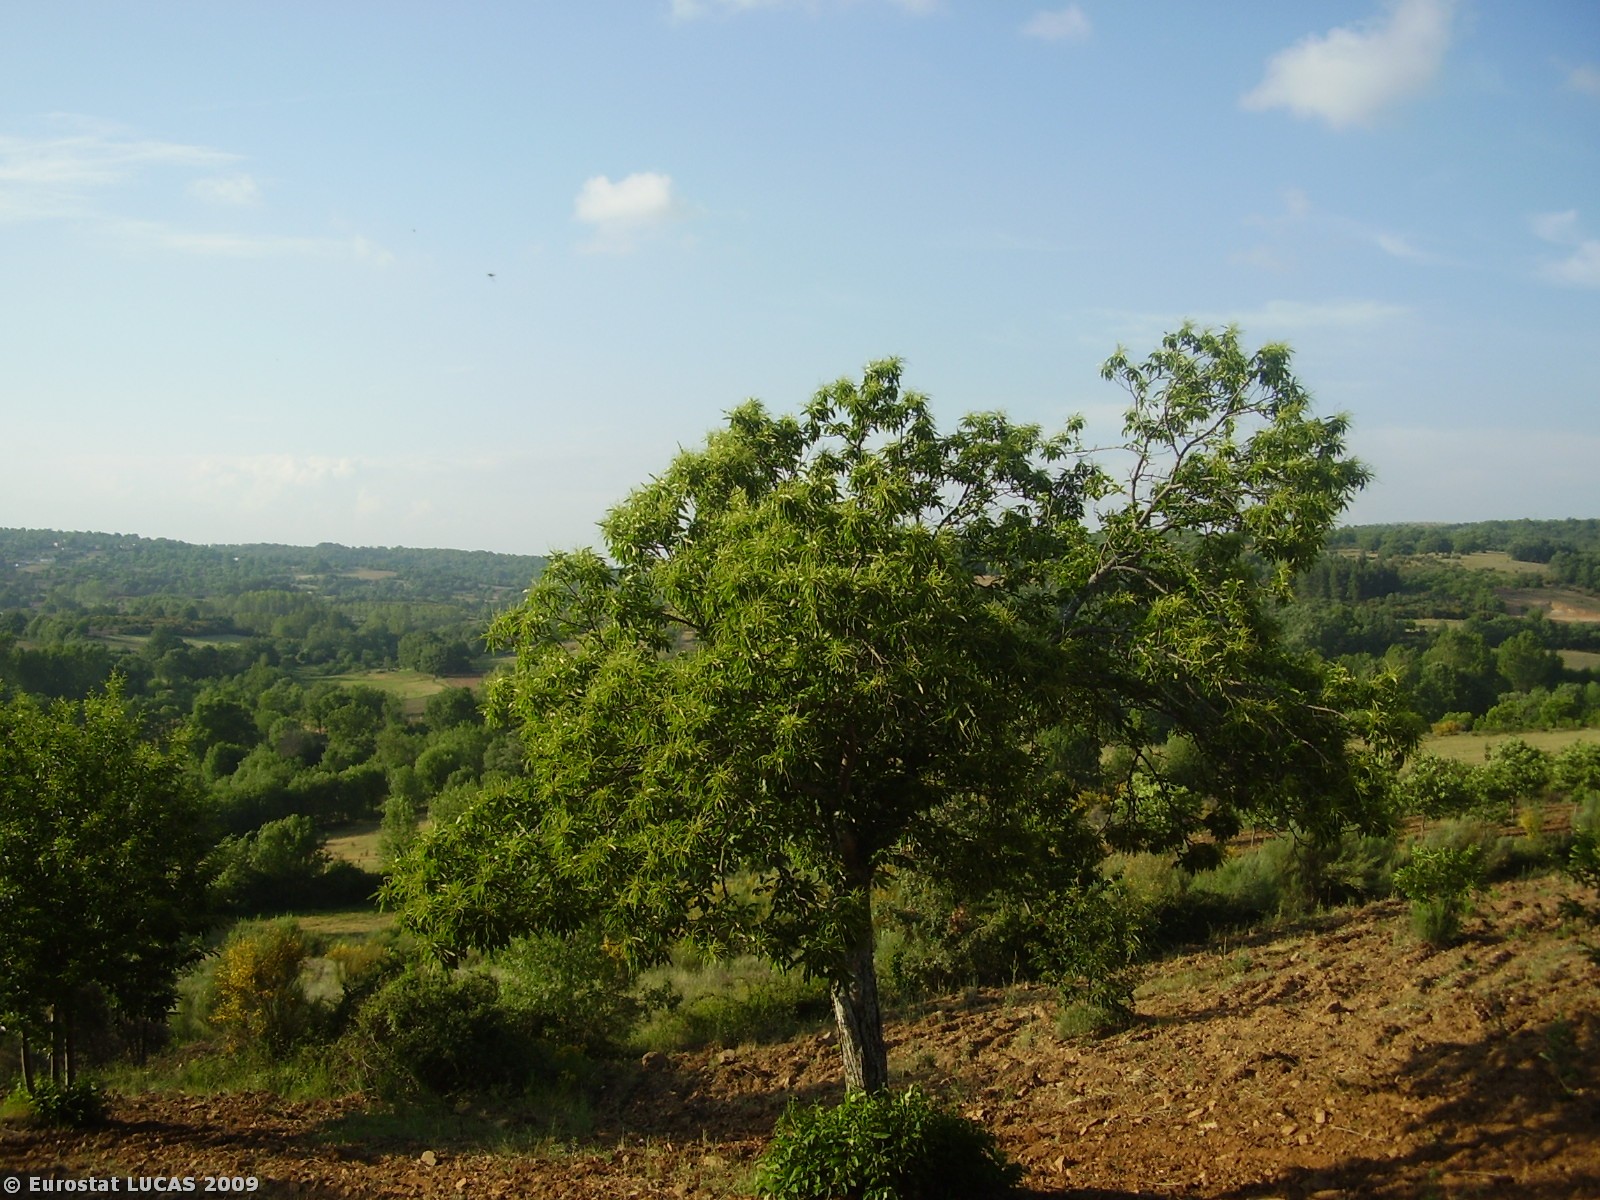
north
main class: Cropland
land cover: Nuts trees
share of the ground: 10 - 25 %
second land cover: Bare land
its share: < 10 %
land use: Agriculture (excluding fallow land and kitchen gardens)
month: June
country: PT
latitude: 41.6243
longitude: -6.8071
